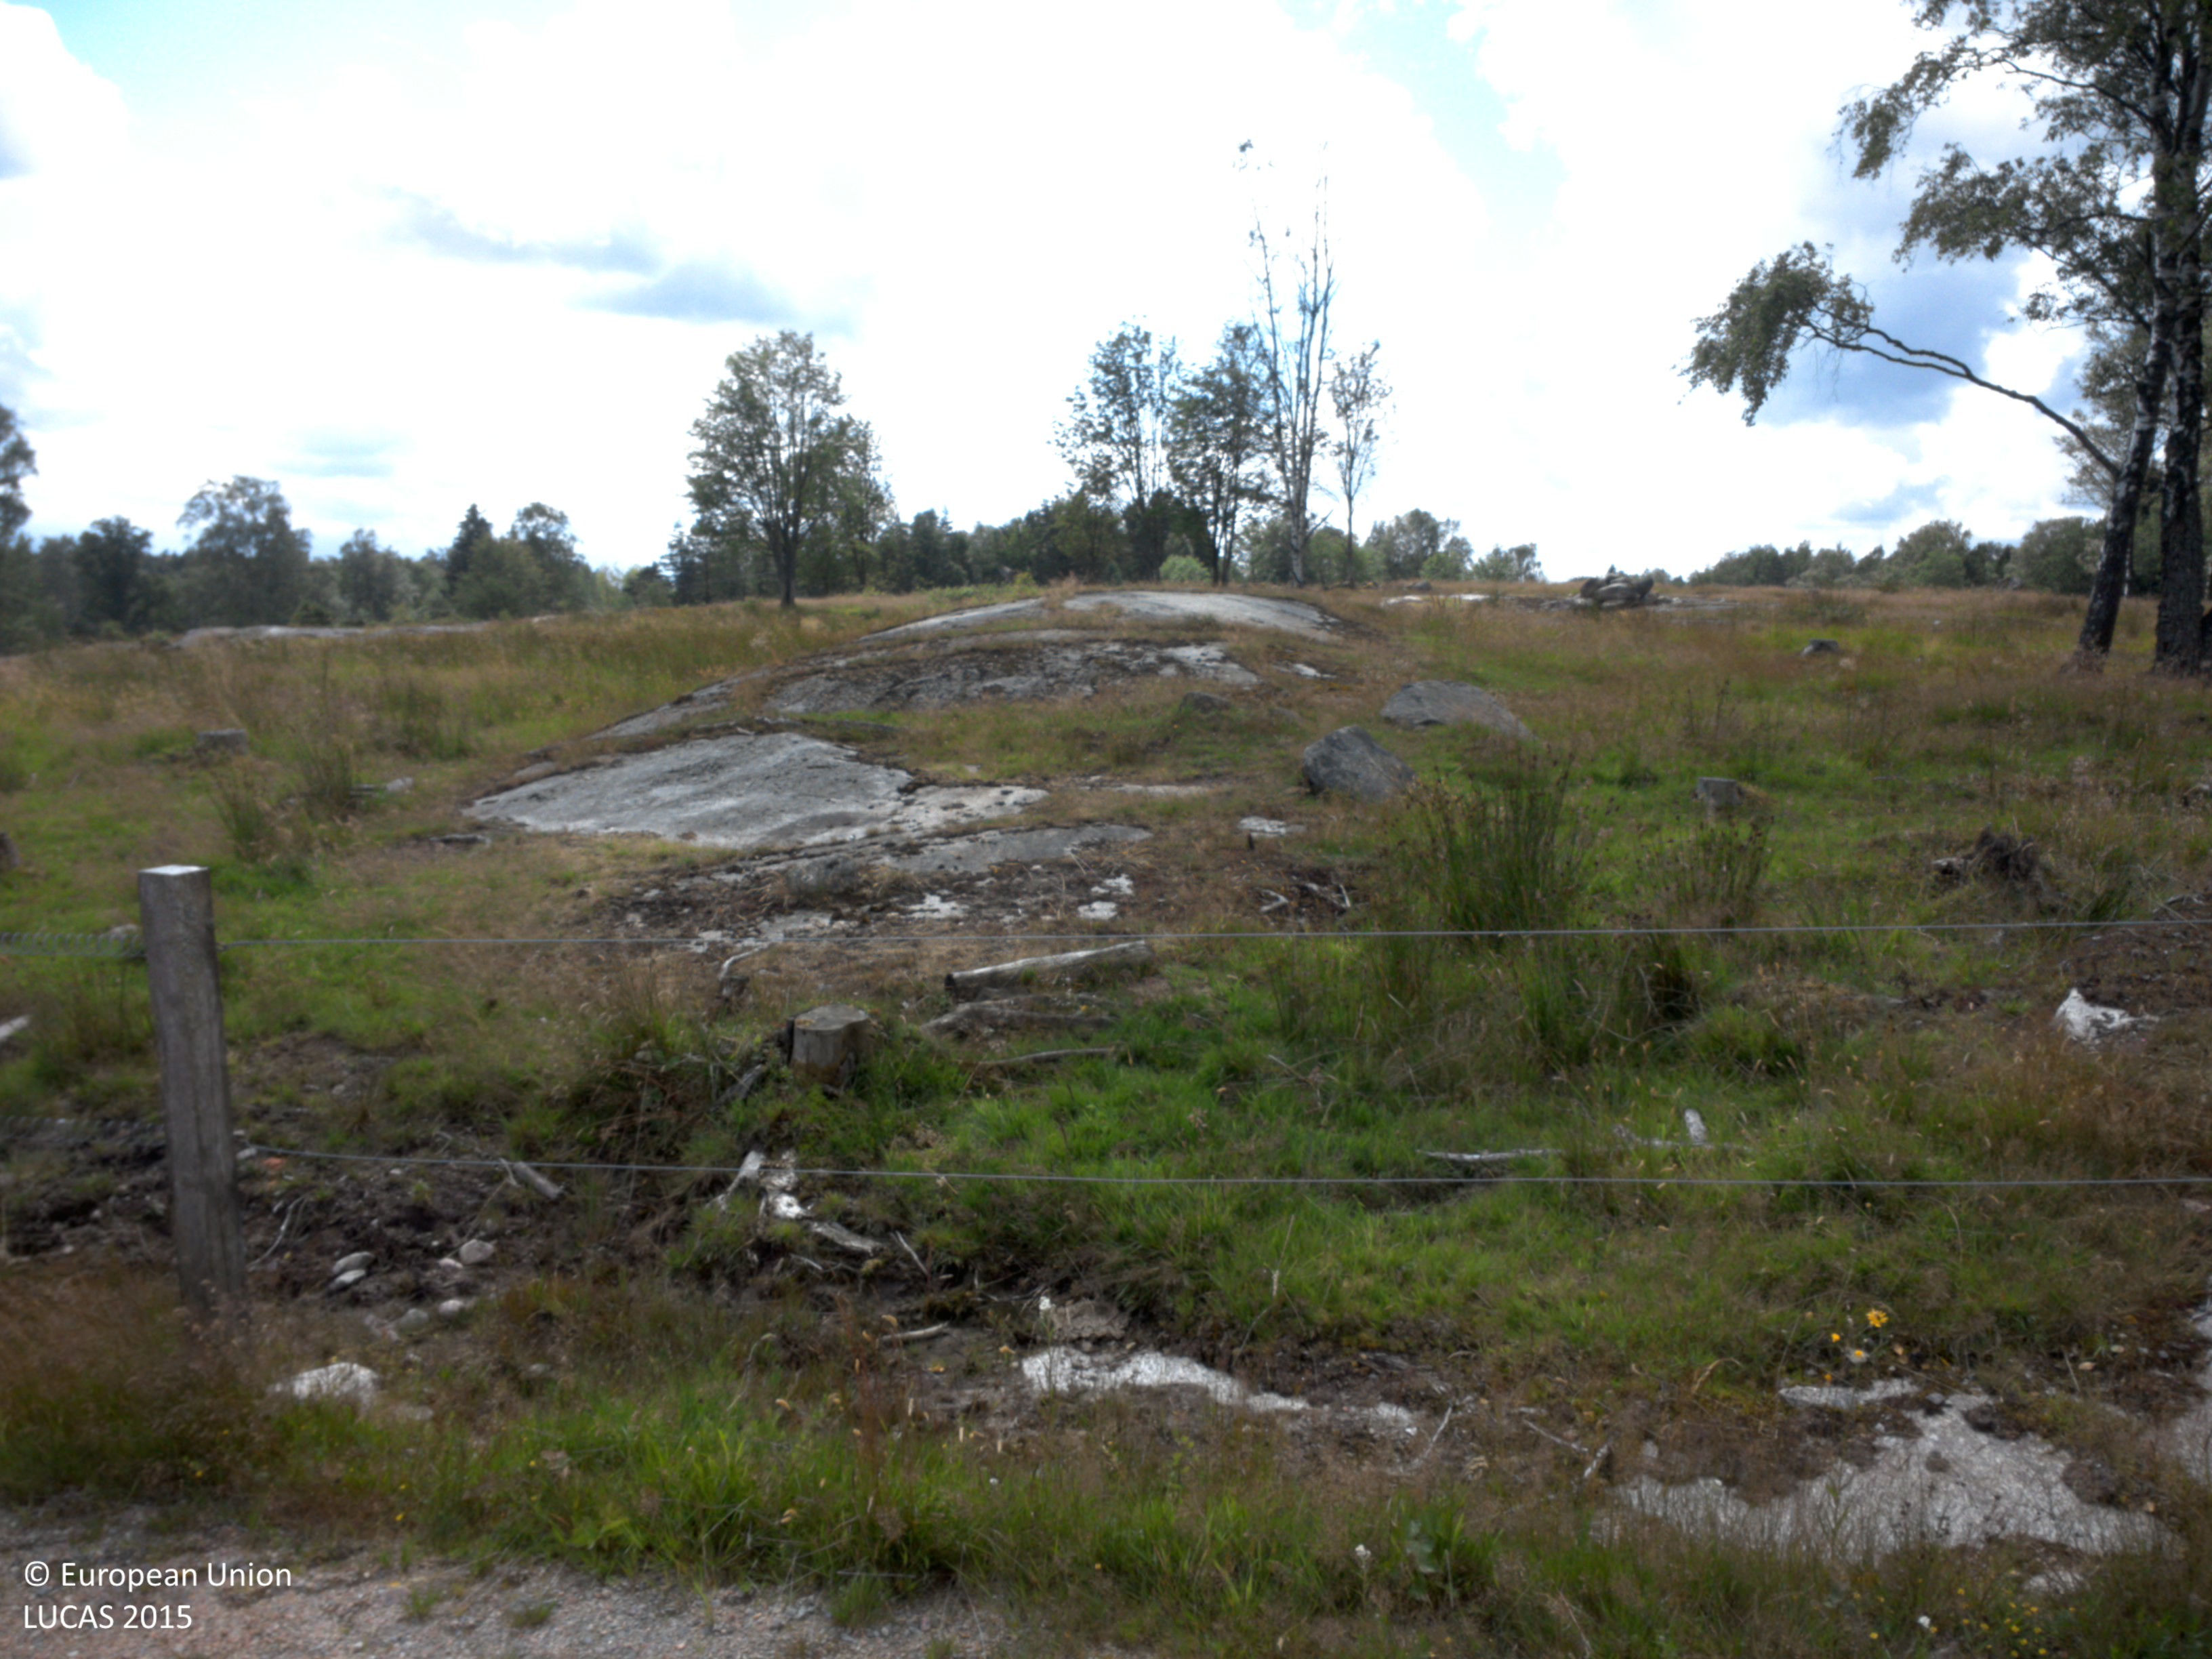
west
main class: Grassland
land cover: Grassland with sparse tree/shrub cover
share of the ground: > 75 %
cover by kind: herbaceous plants 75 %, consolidated bare surface 20 %, broadleaved forest trees 5 %
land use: Agriculture (excluding fallow land and kitchen gardens)
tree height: > 5 m
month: July
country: SE
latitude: 58.1897
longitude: 11.7825
